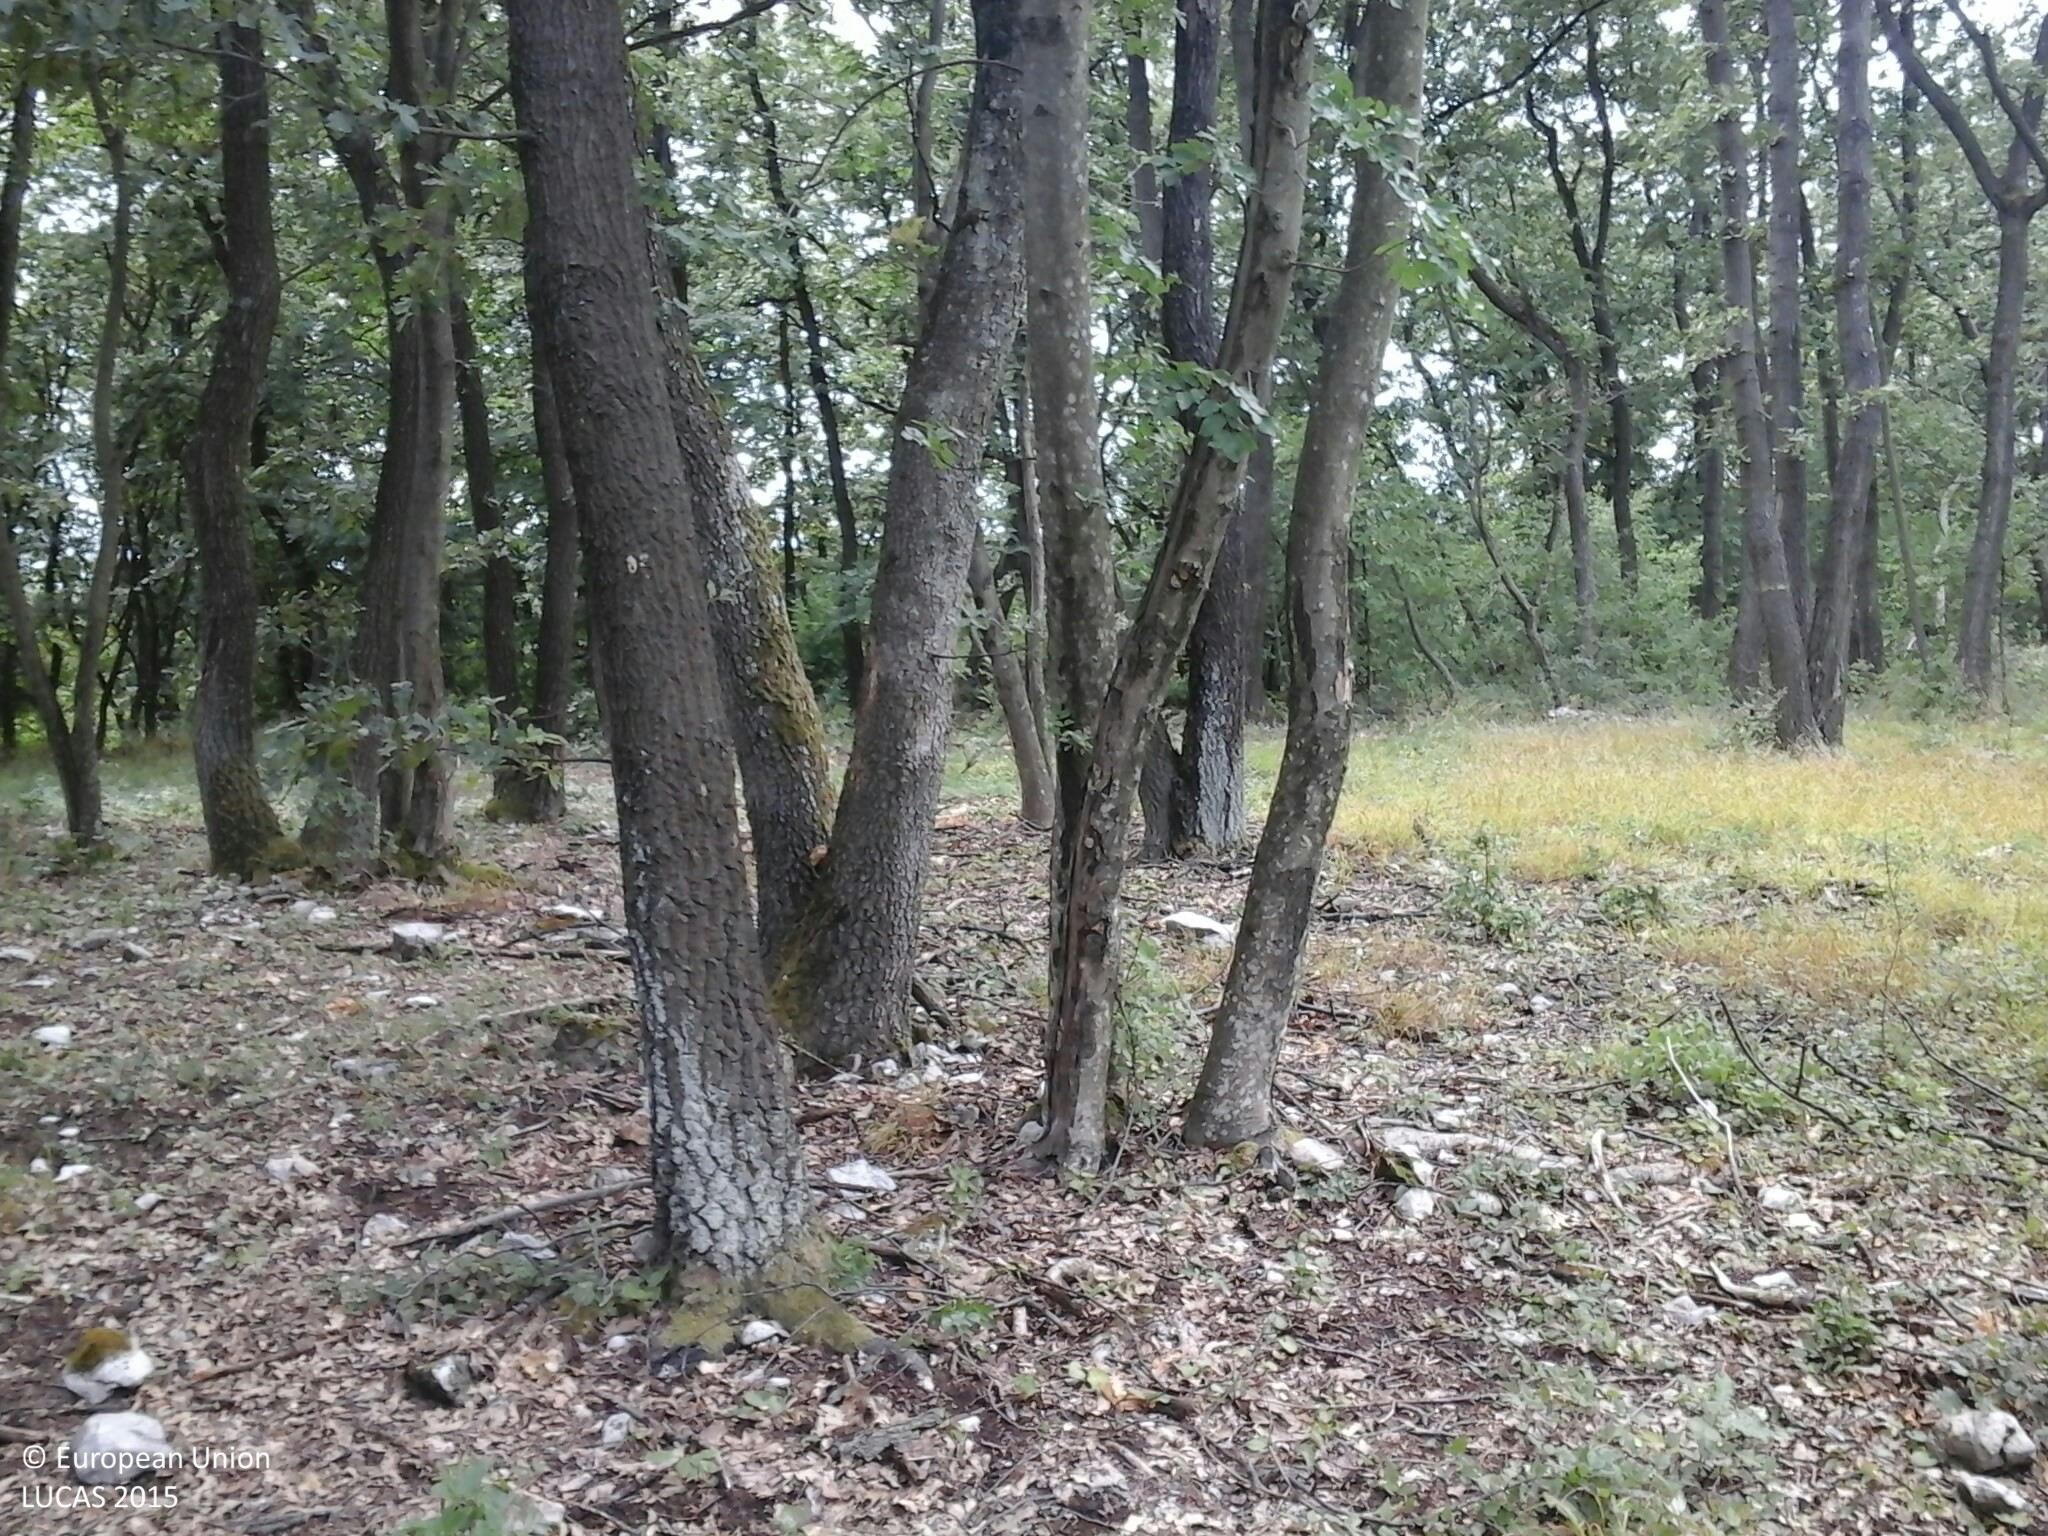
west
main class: Woodland
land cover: Broadleaved woodland
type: acidophilous oak and oak-birch forest
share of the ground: 50 - 75 %
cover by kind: broadleaved forest trees 75 %, herbaceous plants 15 %, consolidated bare surface 10 %
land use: Forestry
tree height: > 5 m
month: July
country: HU
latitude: 46.9563
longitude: 17.7473
